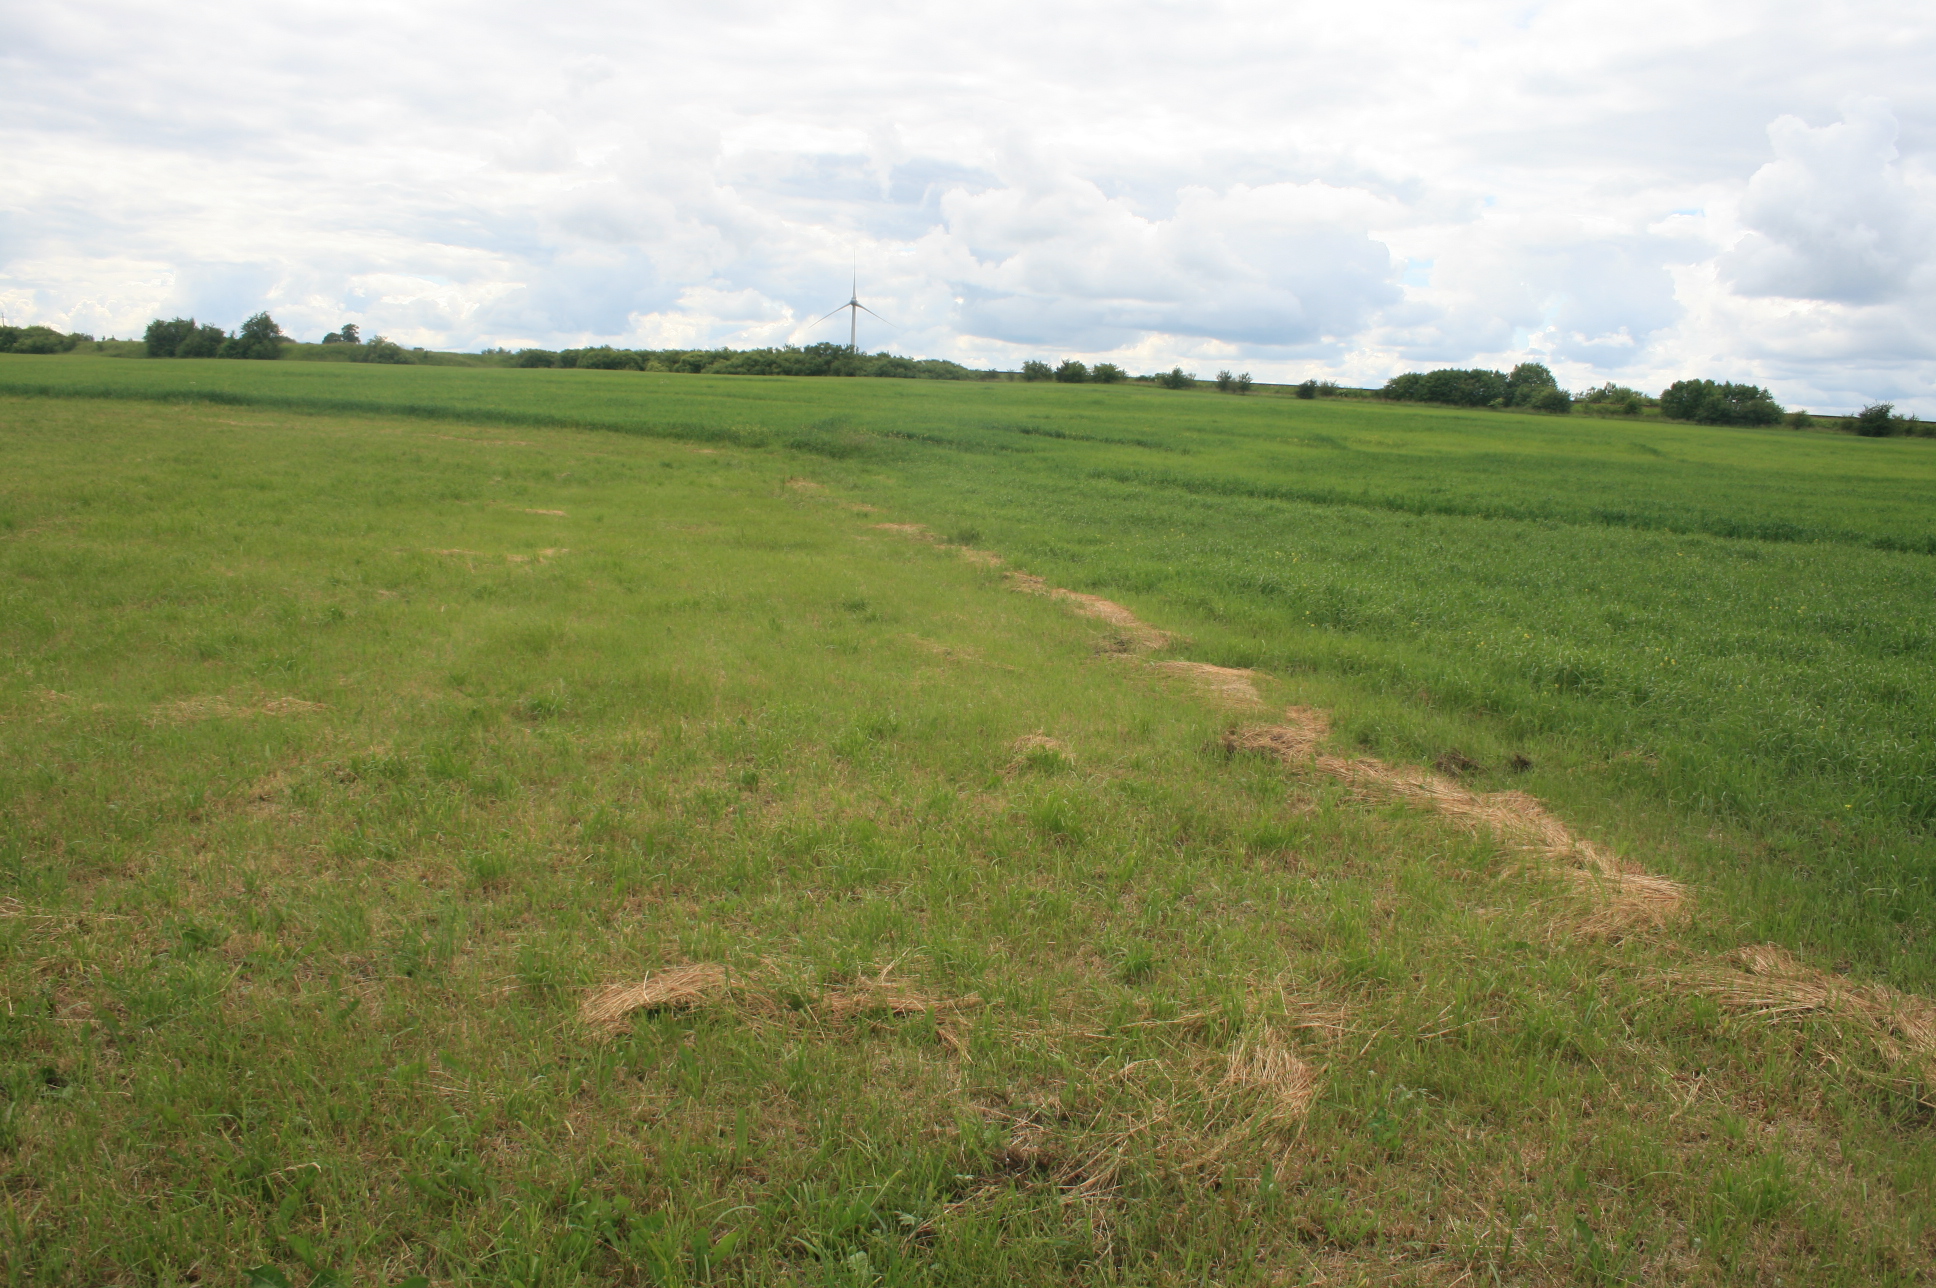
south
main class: Grassland
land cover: Grassland without tree/shrub cover
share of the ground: > 75 %
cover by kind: herbaceous plants 100 %
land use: Agriculture (excluding fallow land and kitchen gardens)
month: June
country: LT
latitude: 55.1849
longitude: 22.0059
